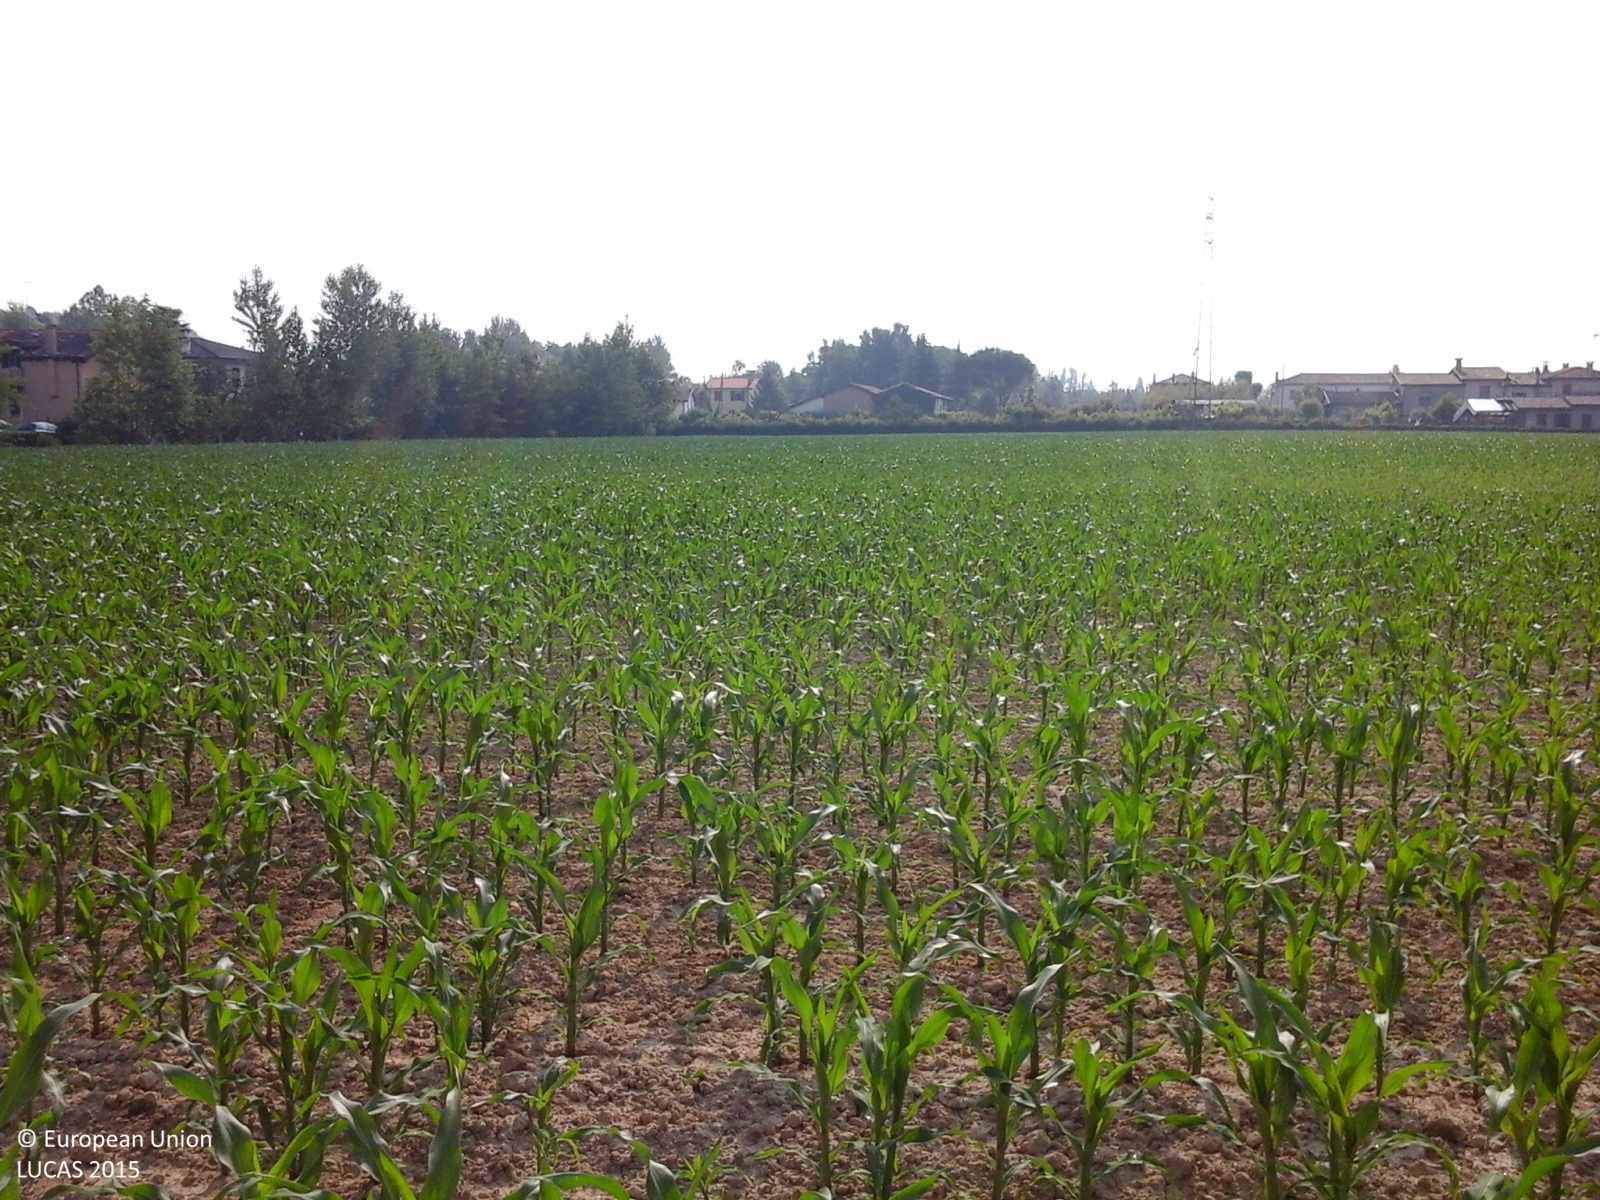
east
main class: Cropland
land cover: Maize
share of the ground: > 75 %
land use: Agriculture (excluding fallow land and kitchen gardens)
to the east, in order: Maize; Managed hedges; Other fresh vegetables; Electric lines; Other fresh vegetables; Artificial constructions in urban areas
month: June
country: IT
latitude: 45.5353
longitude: 12.2120
